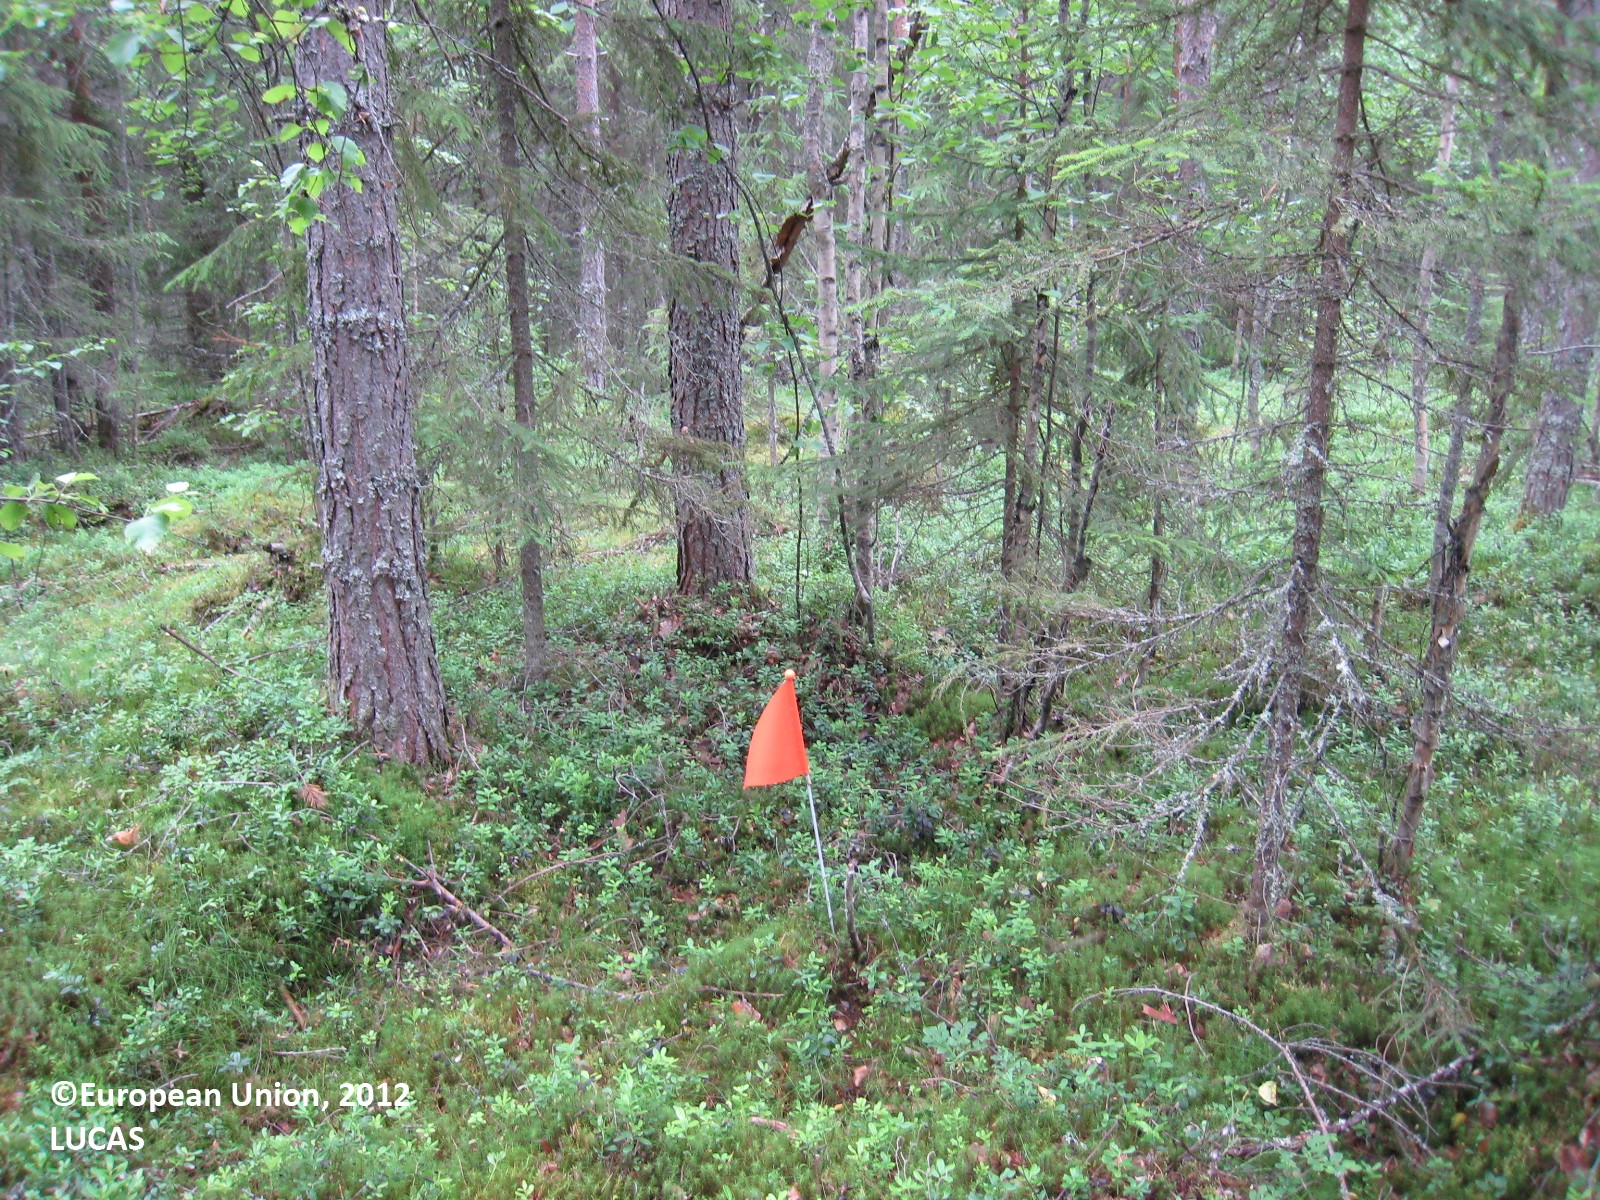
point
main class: Woodland
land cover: Other mixed woodland
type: boreal forest
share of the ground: > 75 %
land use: Forestry
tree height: > 5 m
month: July
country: FI
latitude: 63.2027
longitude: 26.9015
